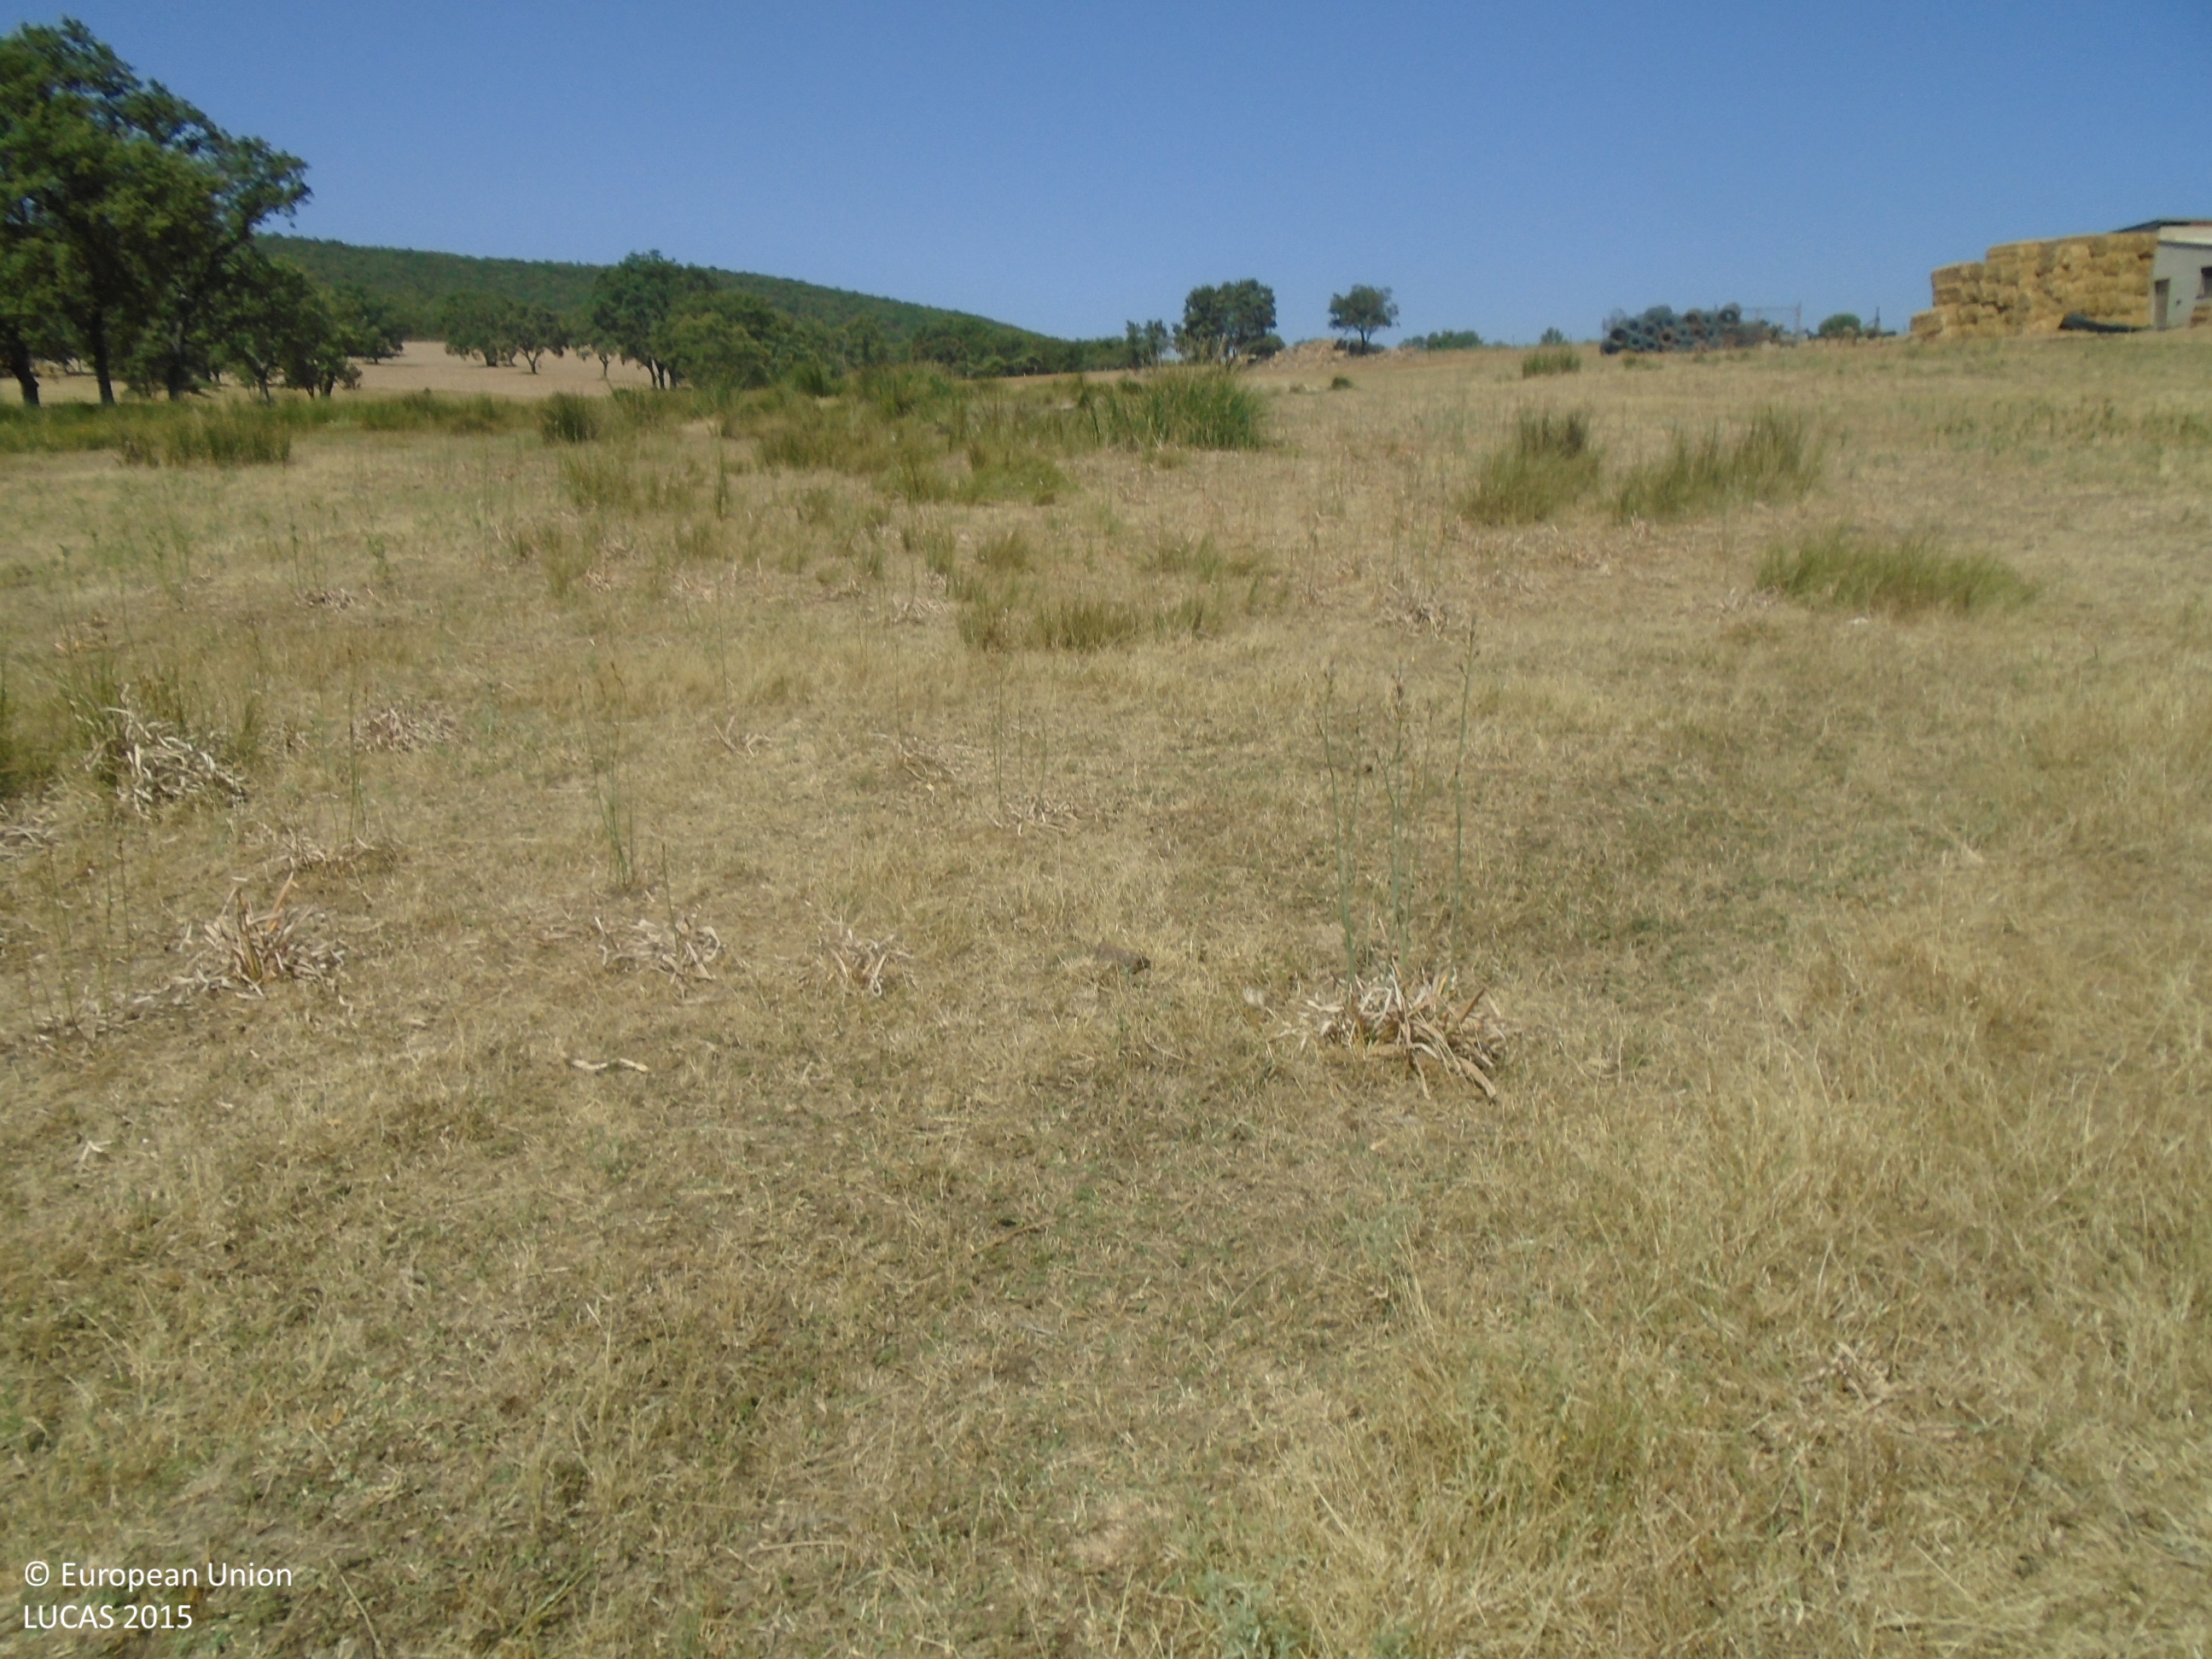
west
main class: Grassland
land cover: Spontaneously vegetated surfaces
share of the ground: > 75 %
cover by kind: herbaceous plants 100 %
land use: Semi-natural and natural areas not in use
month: July
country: ES
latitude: 39.3317
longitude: -4.1234
